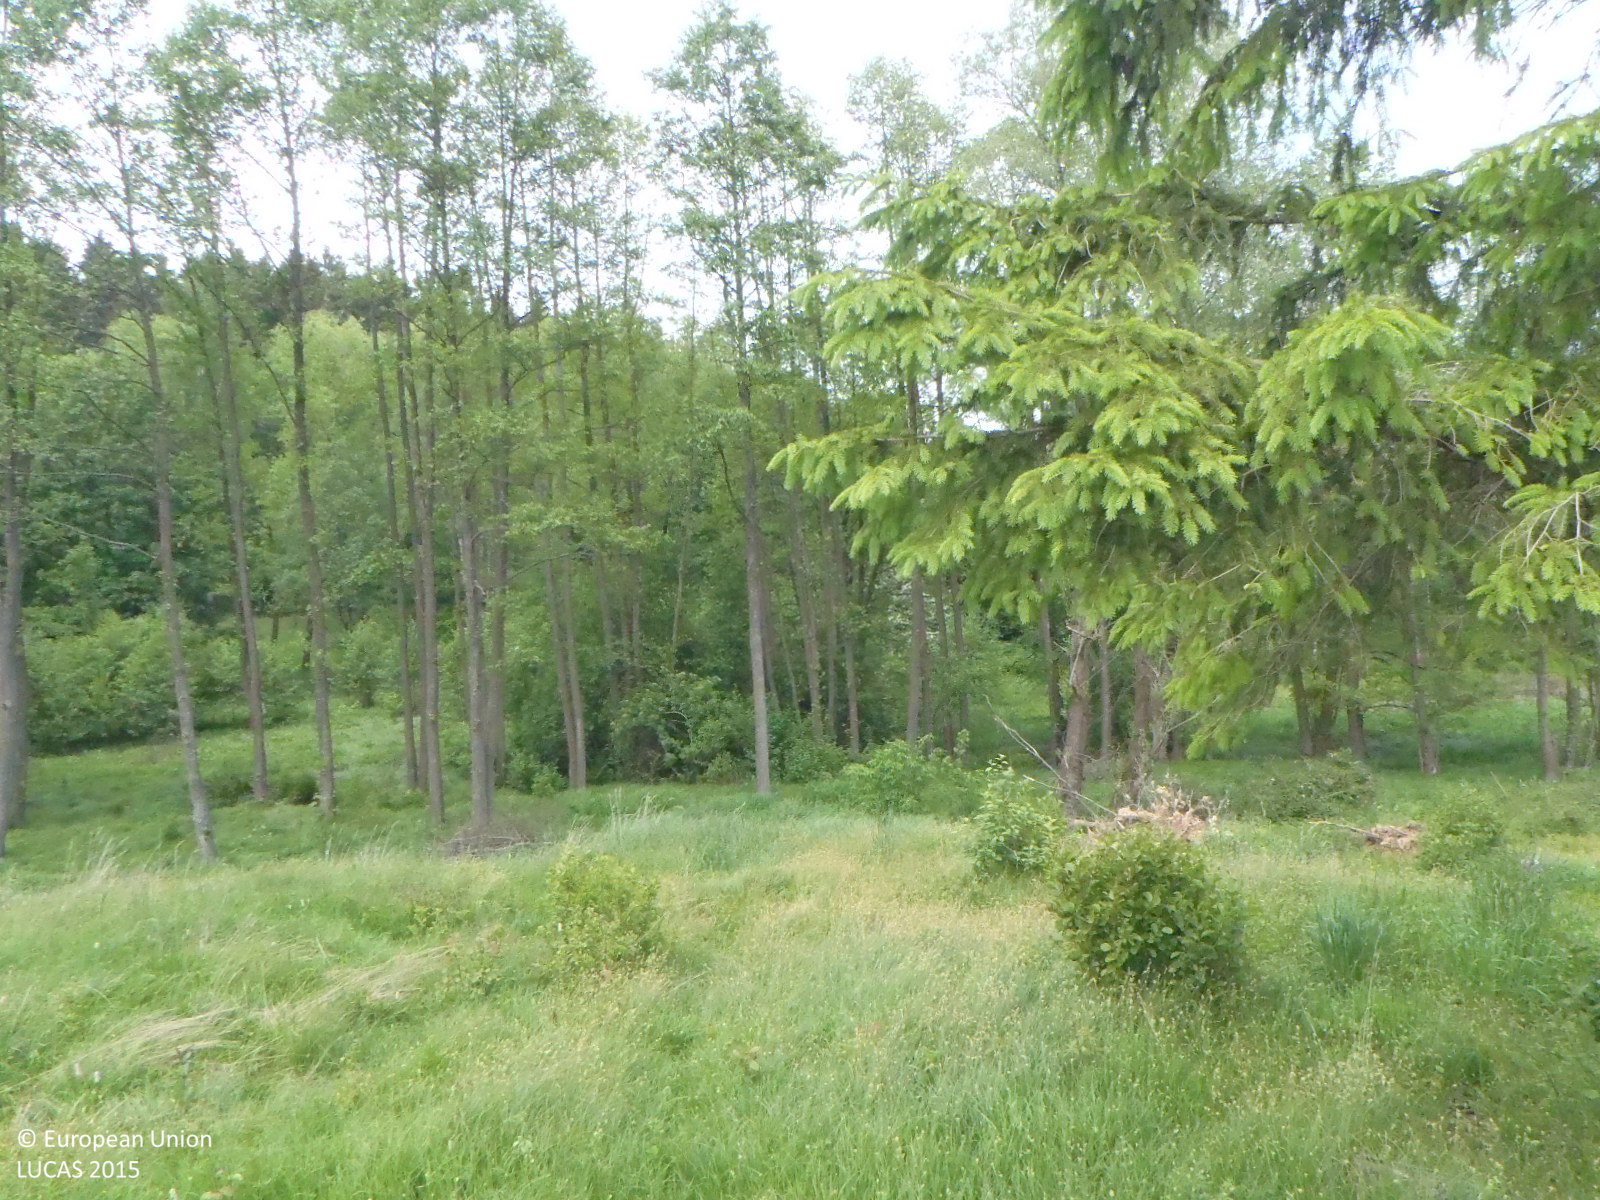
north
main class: Grassland
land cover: Grassland with sparse tree/shrub cover
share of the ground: > 75 %
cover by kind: herbaceous plants 95 %, broadleaved forest trees 5 %
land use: Forestry
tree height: > 5 m
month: June
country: CZ
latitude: 48.6567
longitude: 14.4400
